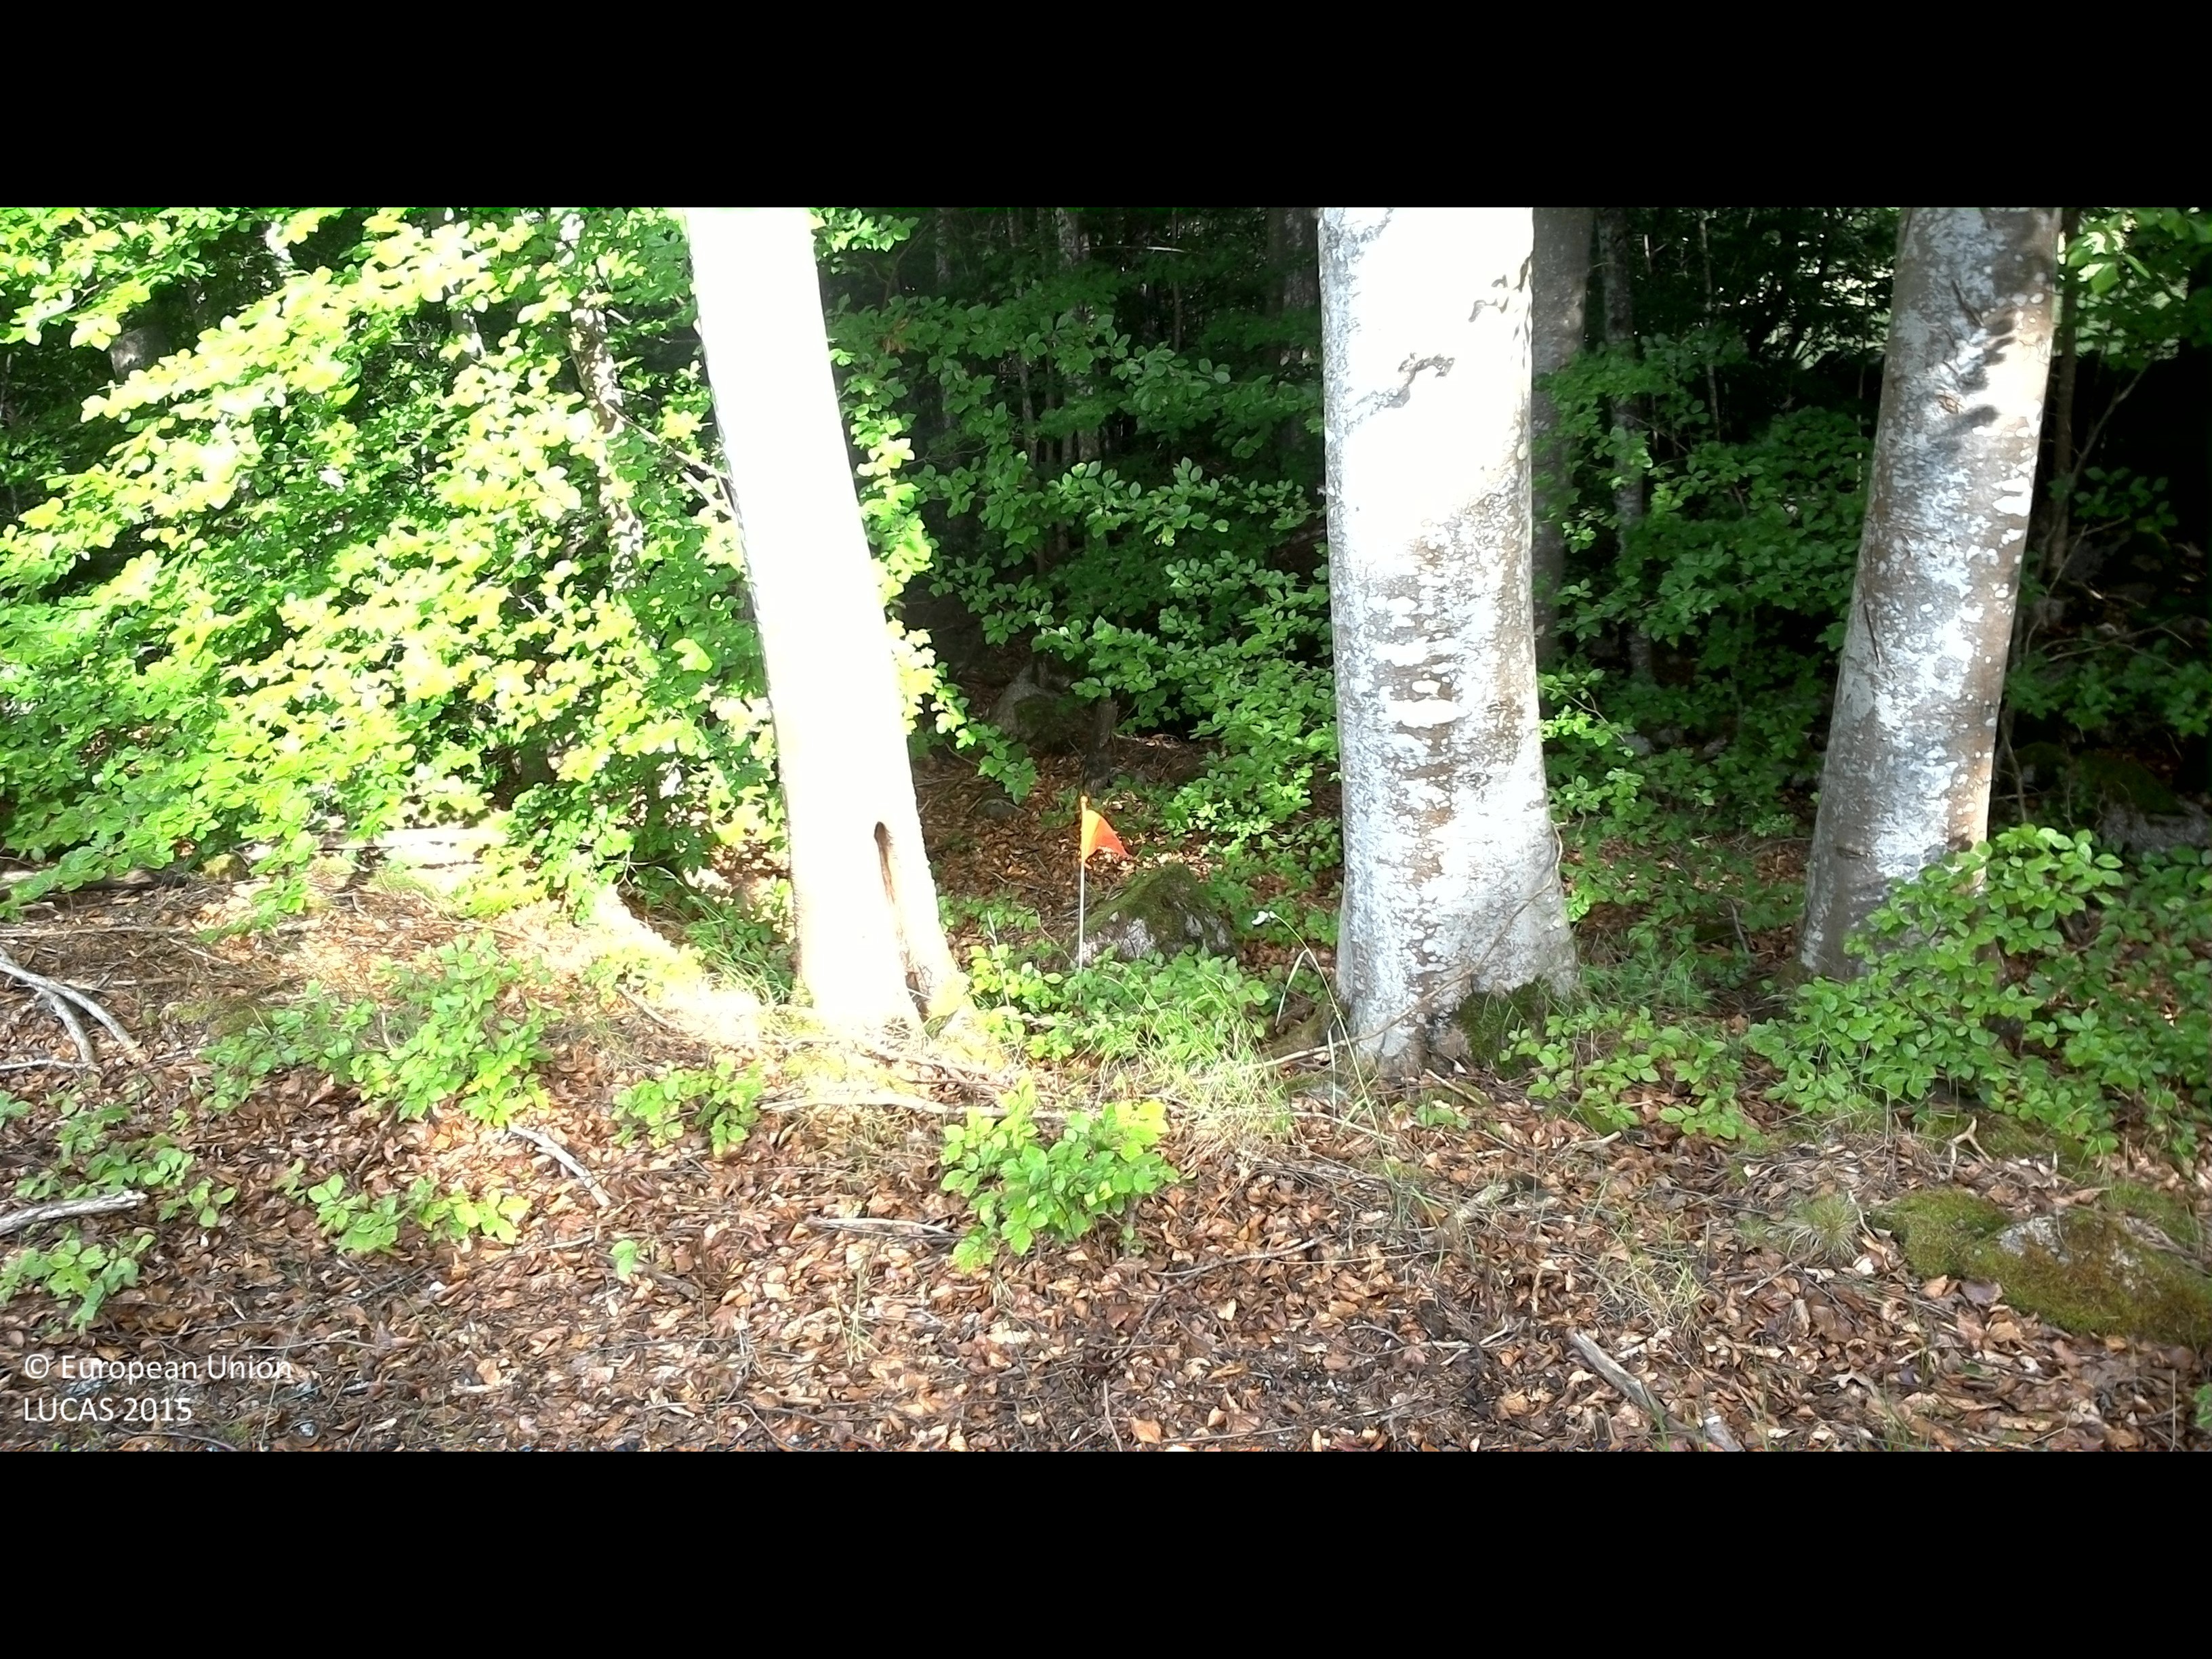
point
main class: Woodland
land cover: Broadleaved woodland
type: beech forest
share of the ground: > 75 %
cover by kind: broadleaved forest trees 90 %, shrubs 5 %, herbaceous plants 5 %
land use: Forestry
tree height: > 5 m
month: June
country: SE
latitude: 56.3090
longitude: 15.8030
